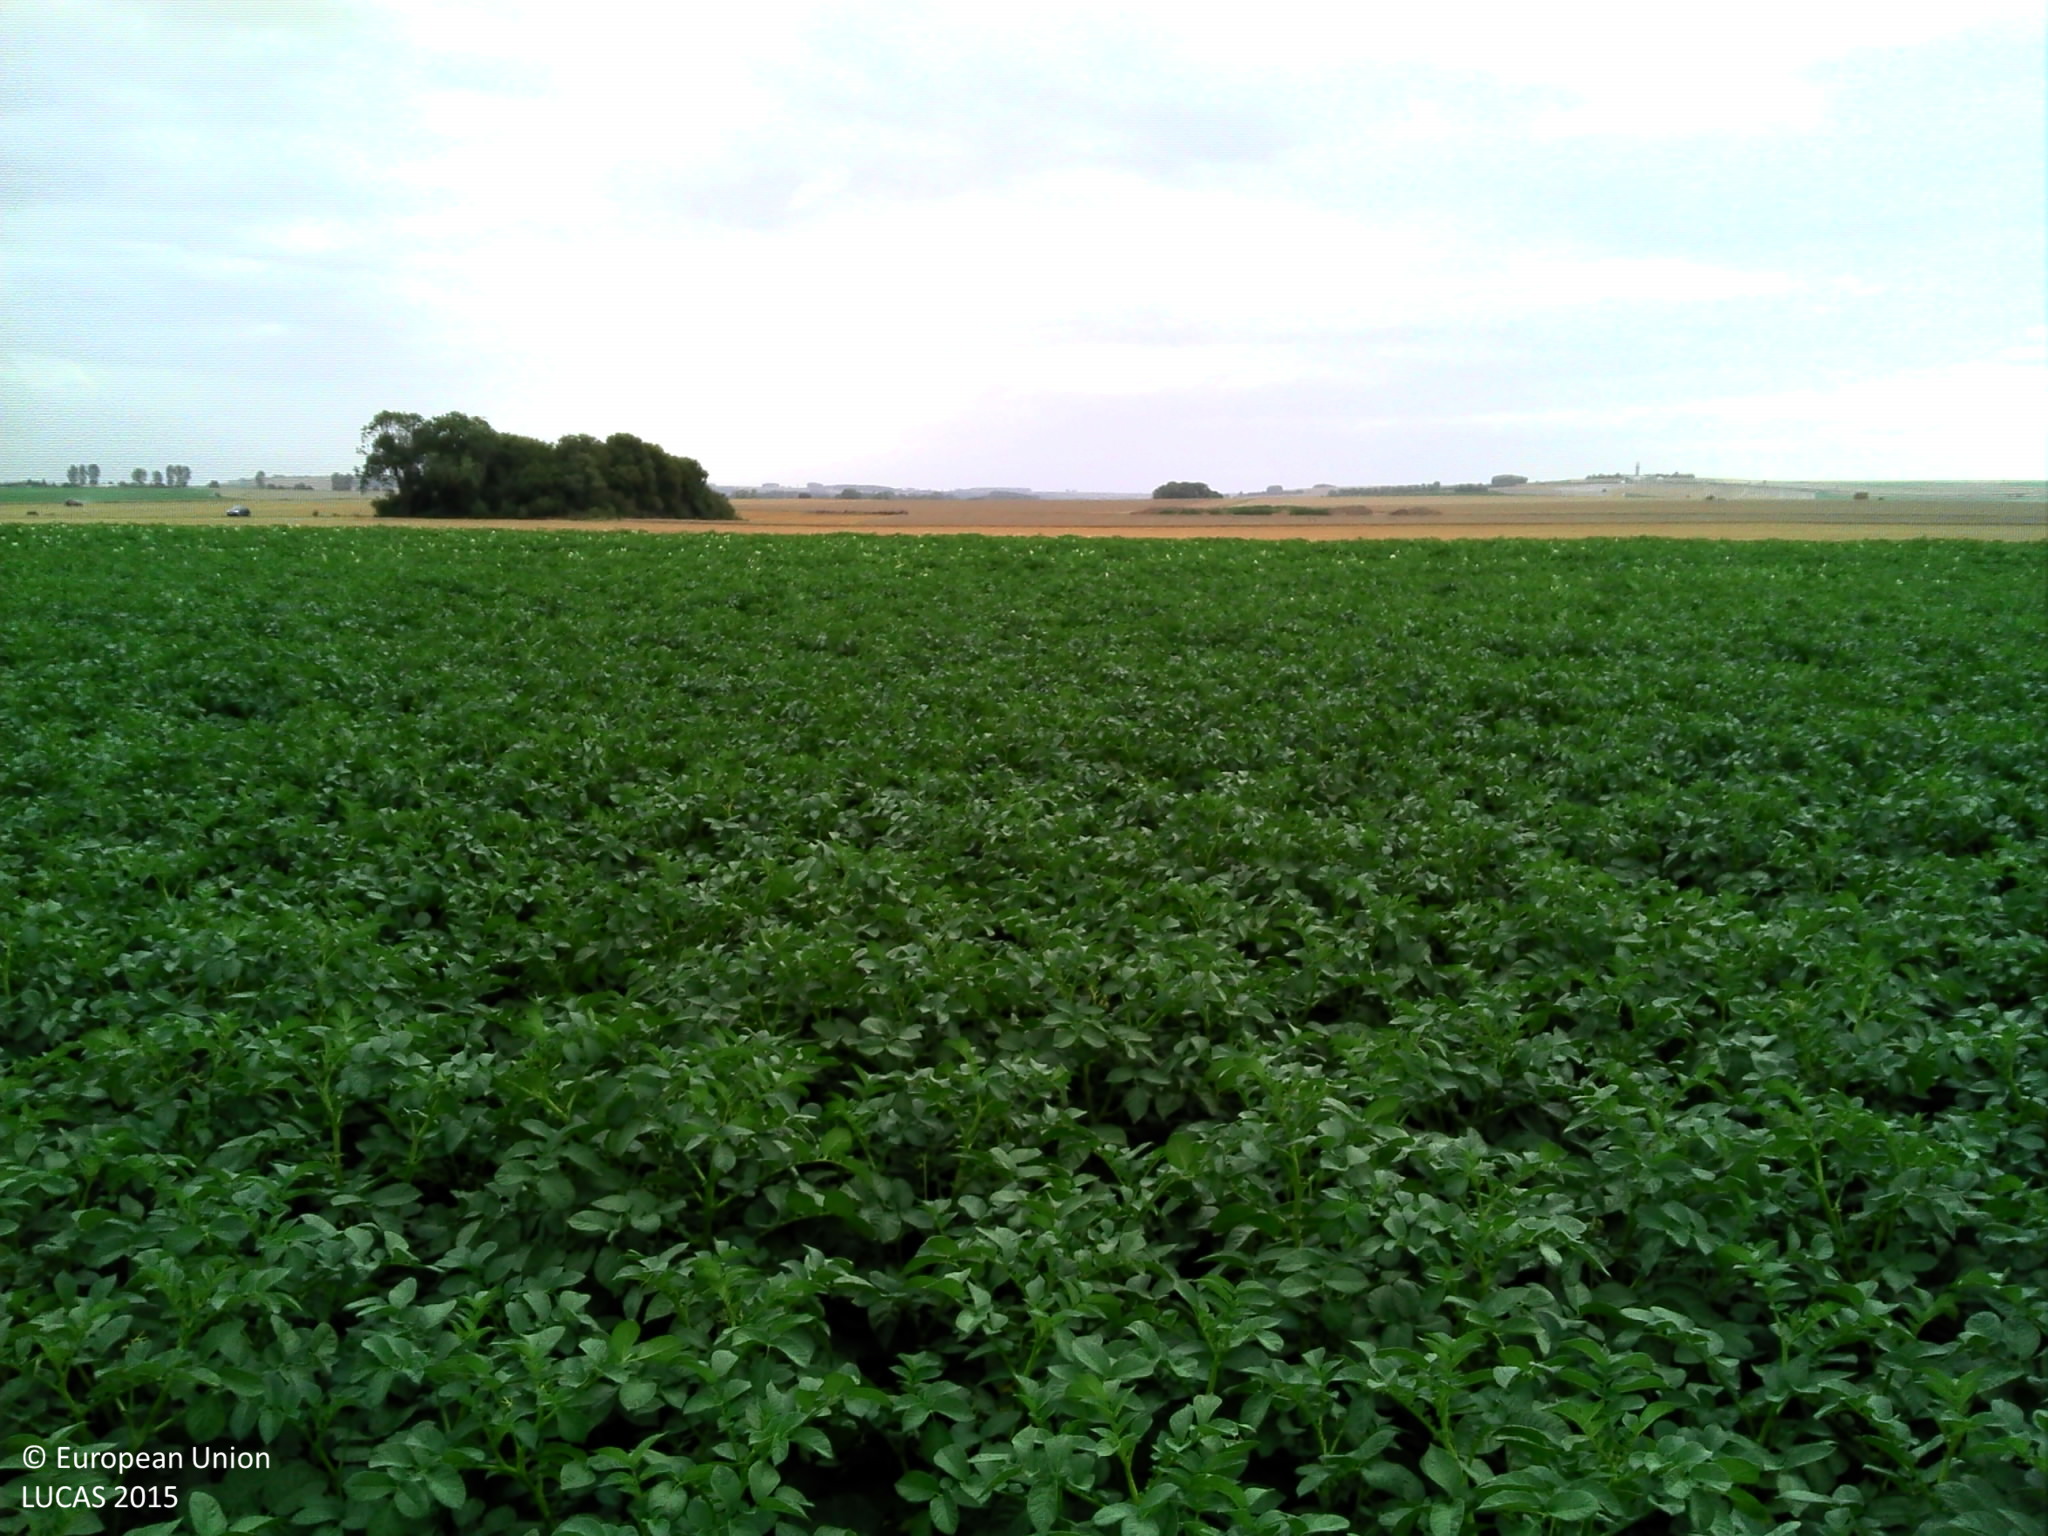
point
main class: Cropland
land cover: Potatoes
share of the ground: > 75 %
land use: Agriculture (excluding fallow land and kitchen gardens)
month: July
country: FR
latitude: 49.8801
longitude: 2.4587
